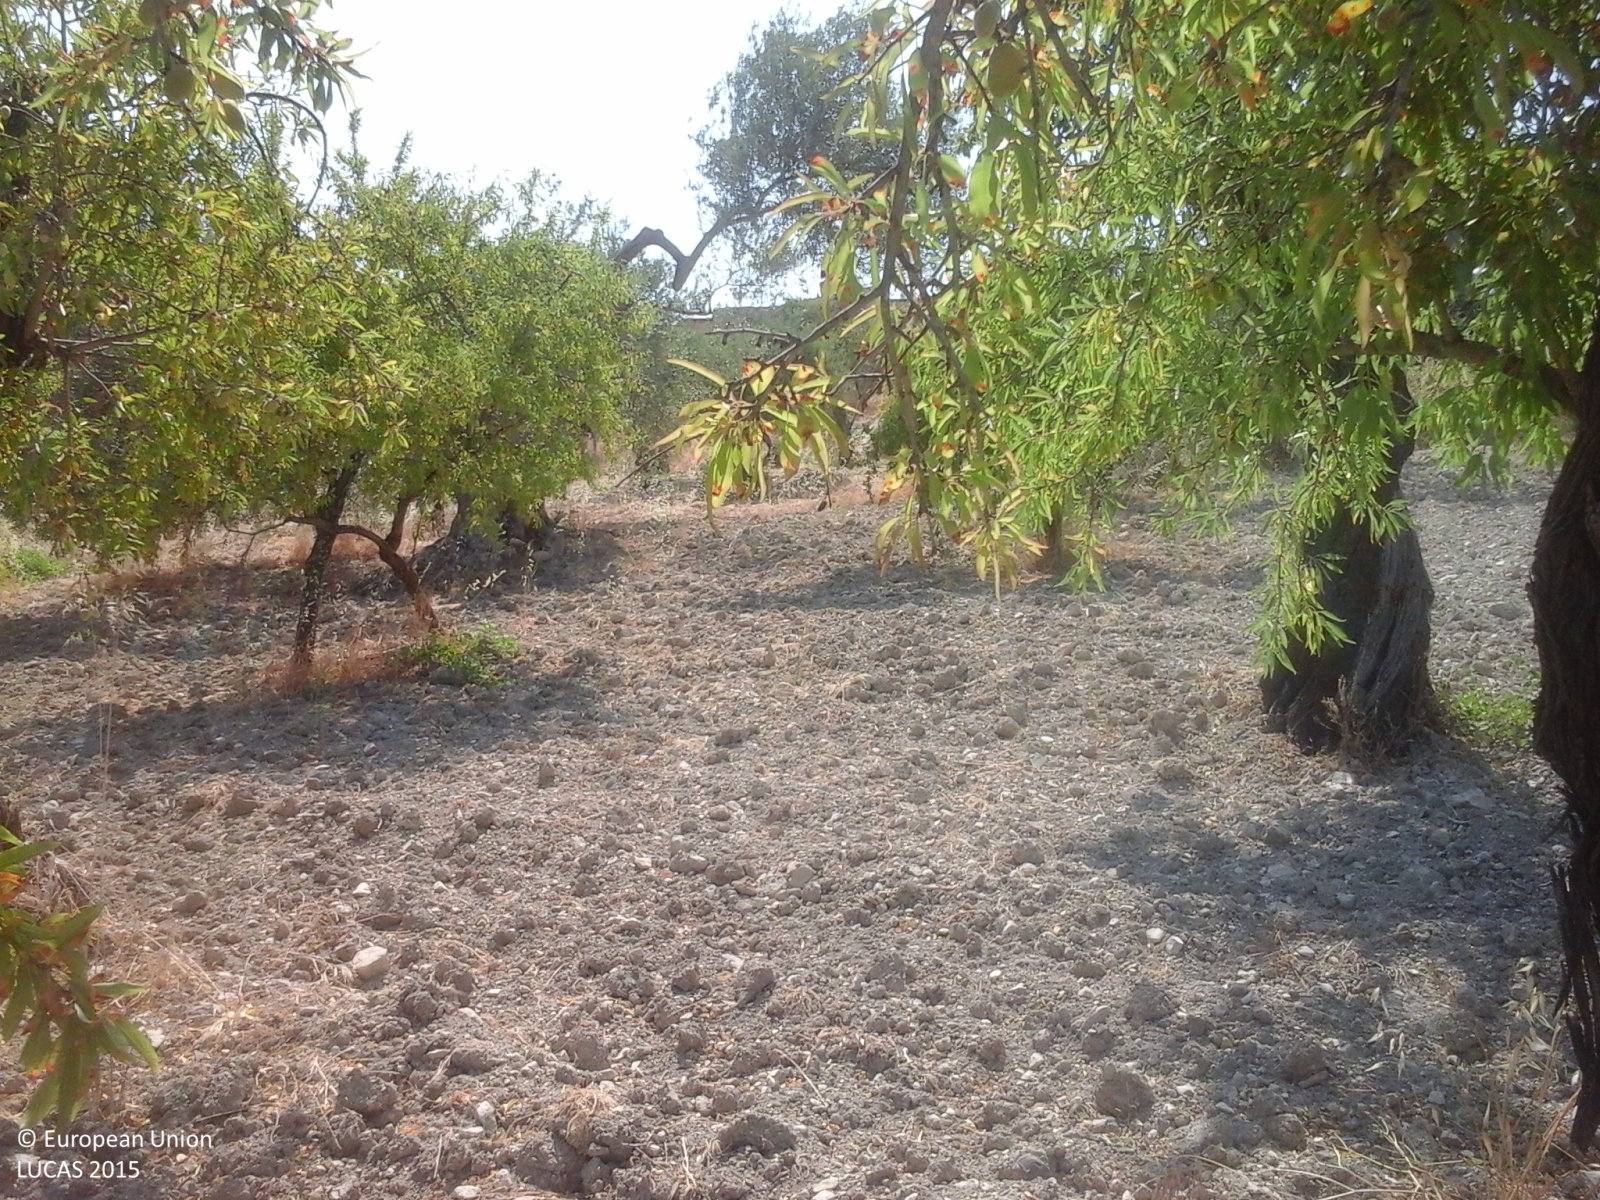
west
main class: Cropland
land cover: Nuts trees
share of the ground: 25 - 50 %
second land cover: Other bare soil
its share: > 75 %
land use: Agriculture (excluding fallow land and kitchen gardens)
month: July
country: IT
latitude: 37.4250
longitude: 13.5998
